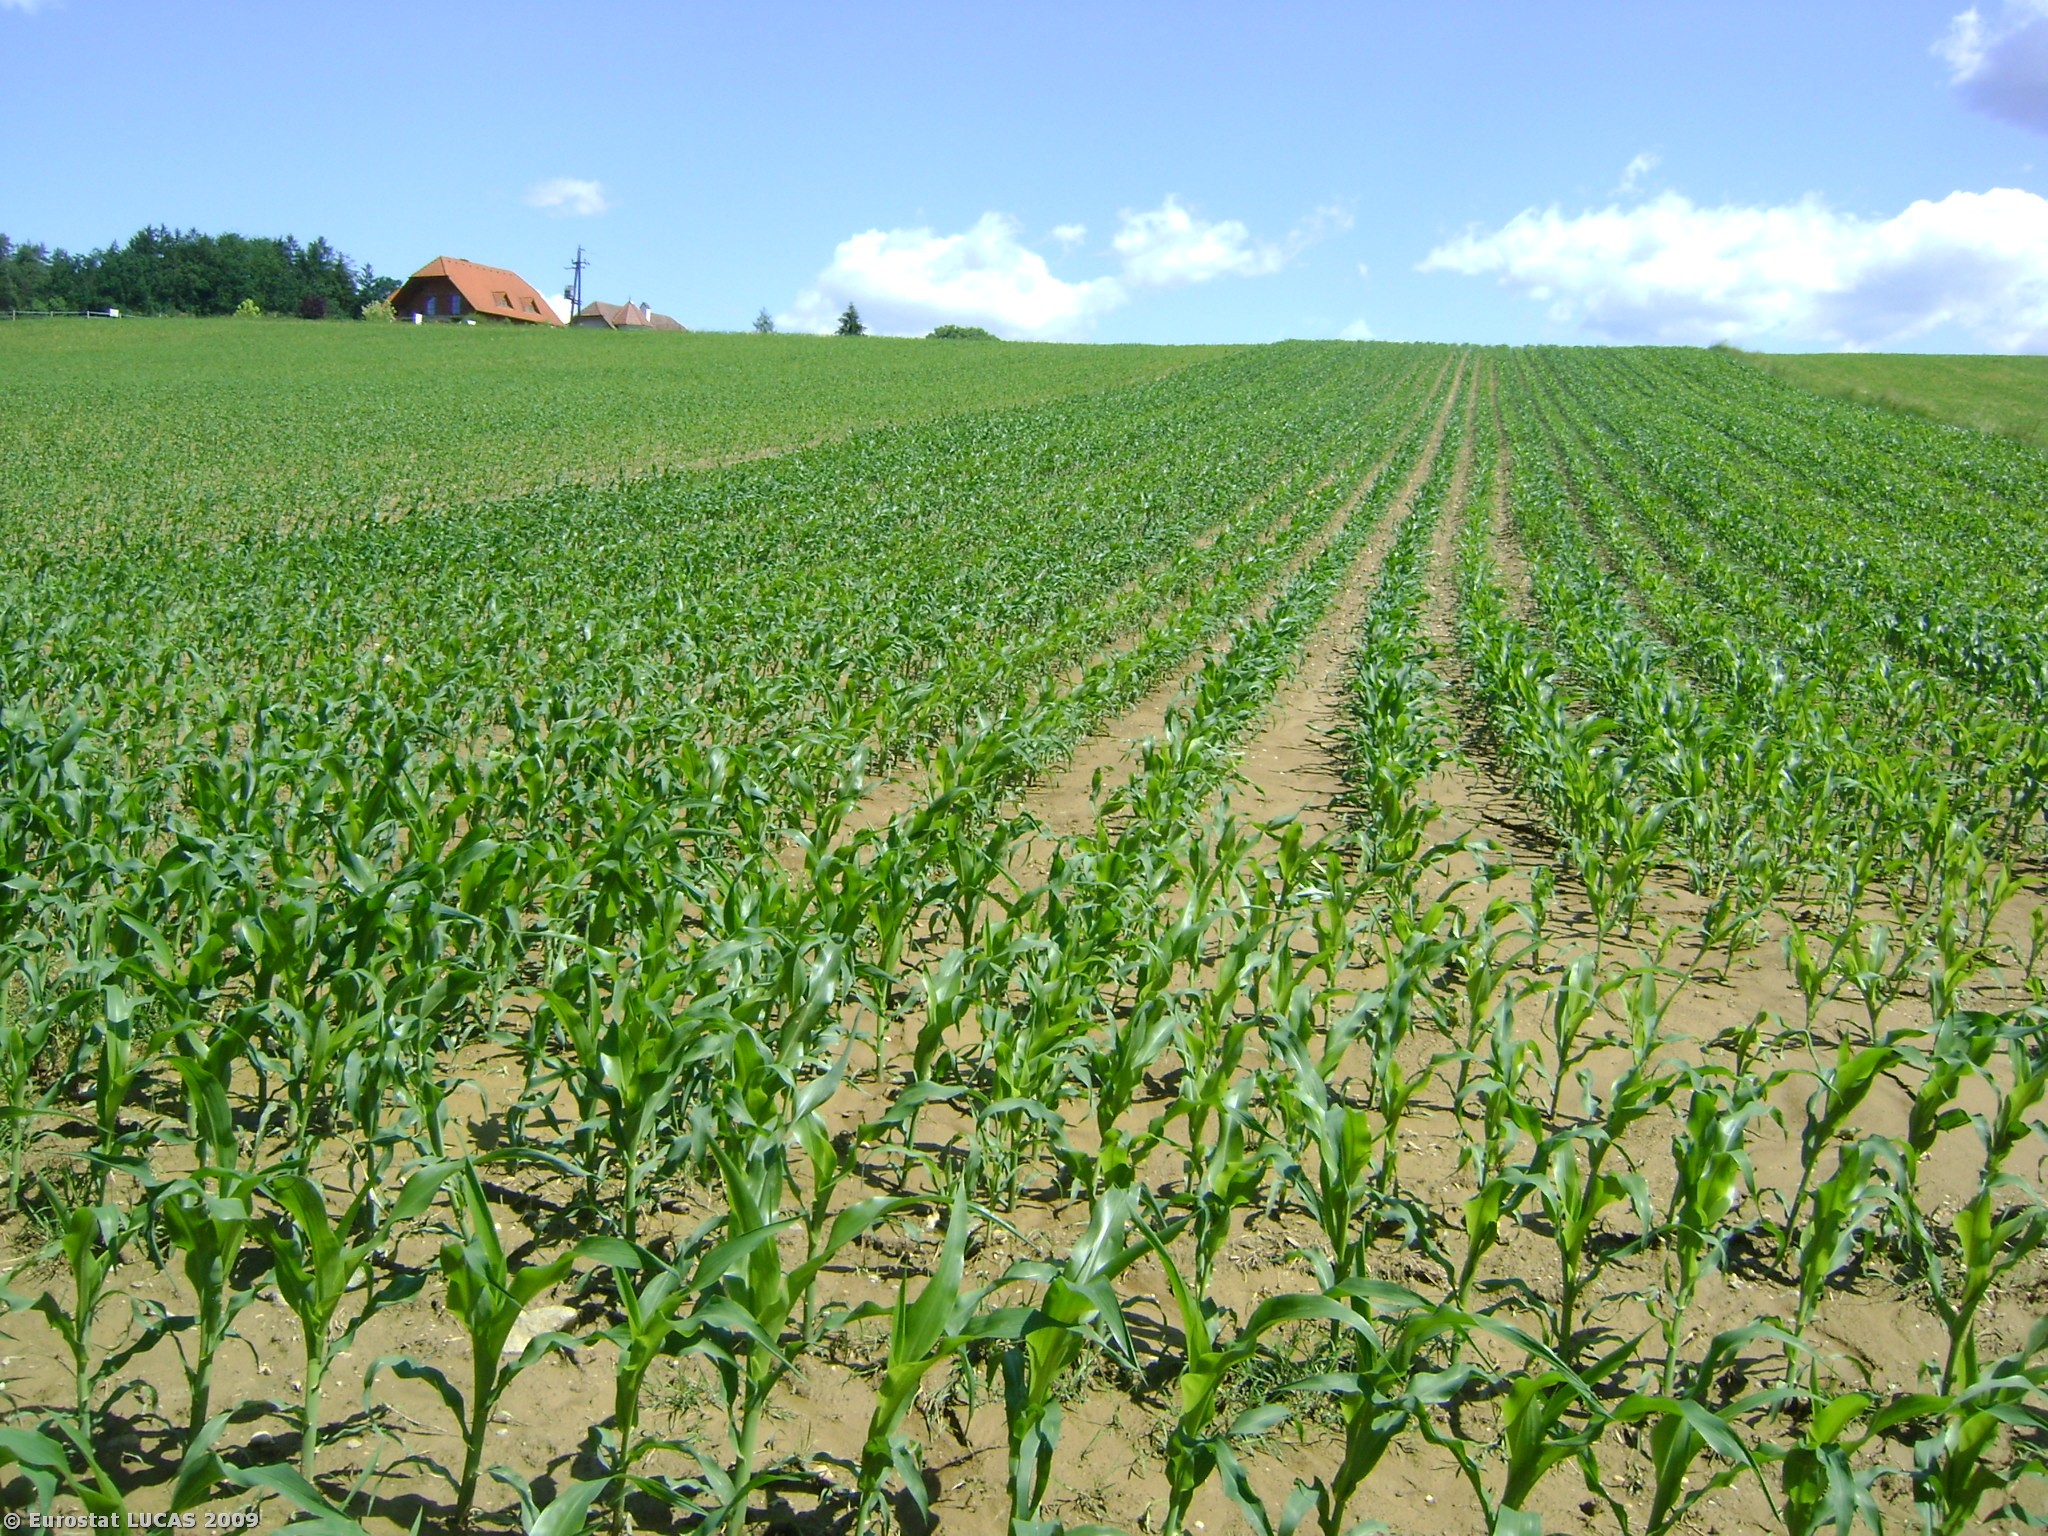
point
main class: Cropland
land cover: Maize
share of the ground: 25 - 50 %
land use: Agriculture (excluding fallow land and kitchen gardens)
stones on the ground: < 10 %
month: May
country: AT
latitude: 46.8130
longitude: 15.7007
